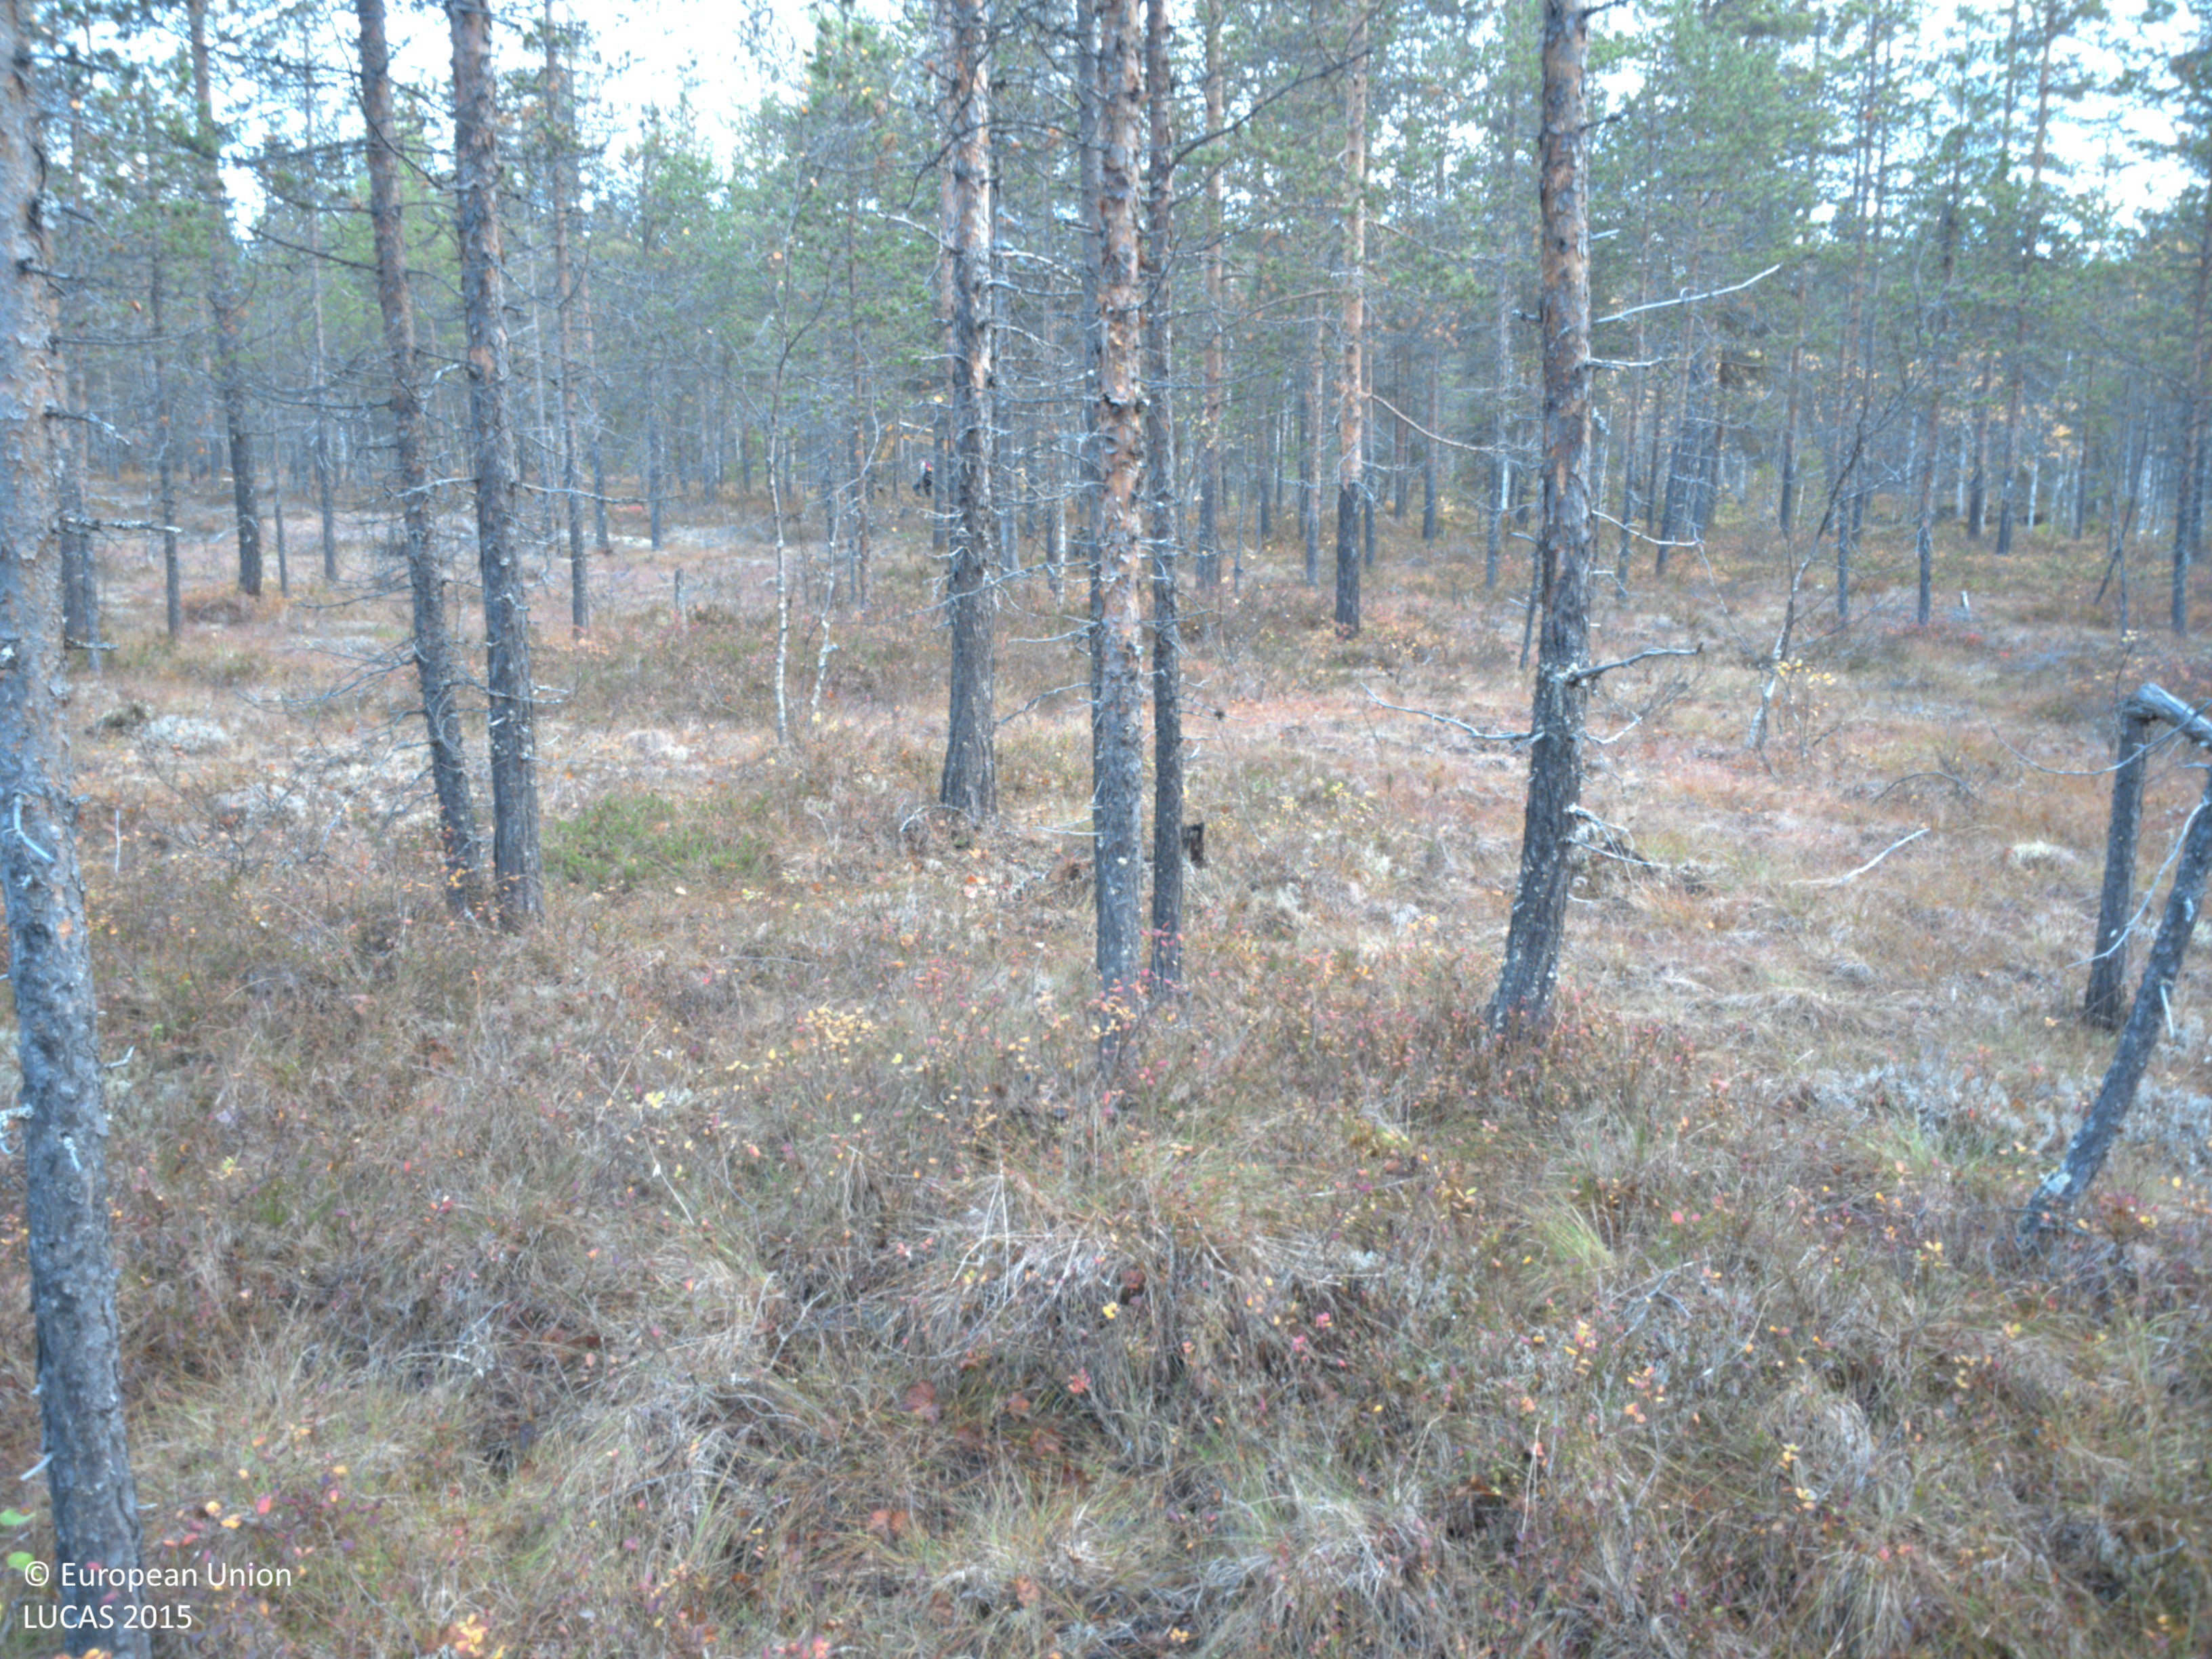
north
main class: Woodland
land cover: Pine dominated coniferous woodland
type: boreal forest
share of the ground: 50 - 75 %
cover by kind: coniferous forest trees 55 %, herbaceous plants 20 %, lichens and mosses 15 %, shrubs 10 %
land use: Forestry
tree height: > 5 m
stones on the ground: < 10 %
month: September
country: SE
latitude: 65.0574
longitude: 18.5711
